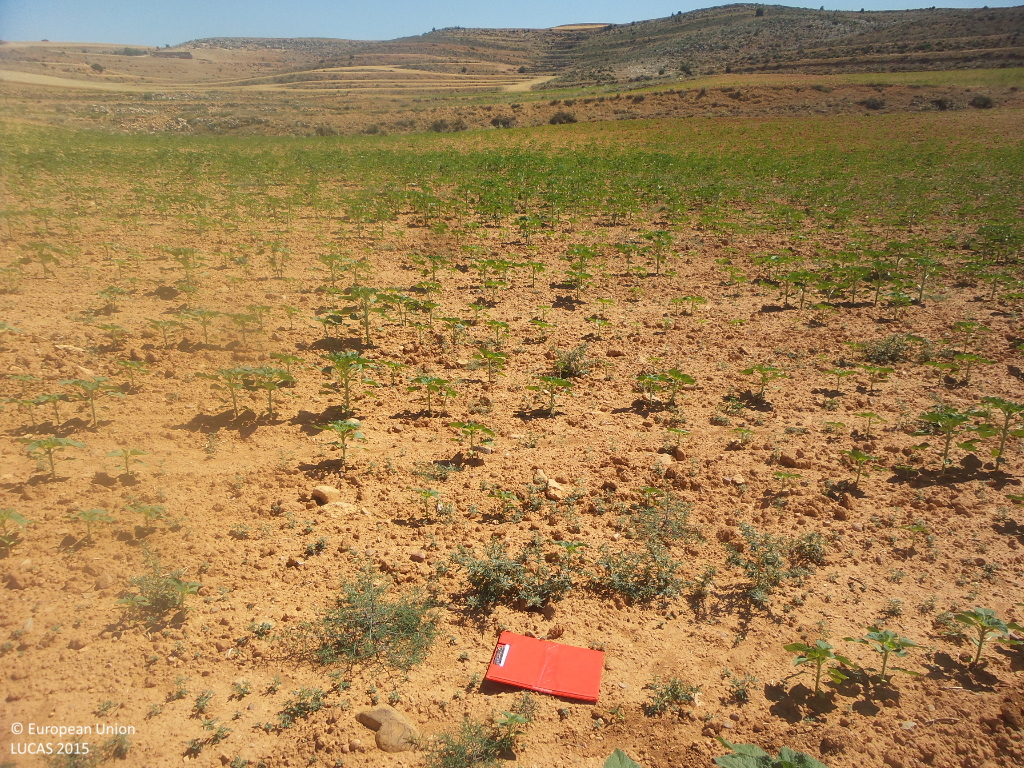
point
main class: Cropland
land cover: Sunflower
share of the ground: < 10 %
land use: Agriculture (excluding fallow land and kitchen gardens)
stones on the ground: < 10 %
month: July
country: ES
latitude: 41.1794
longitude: -1.9352
